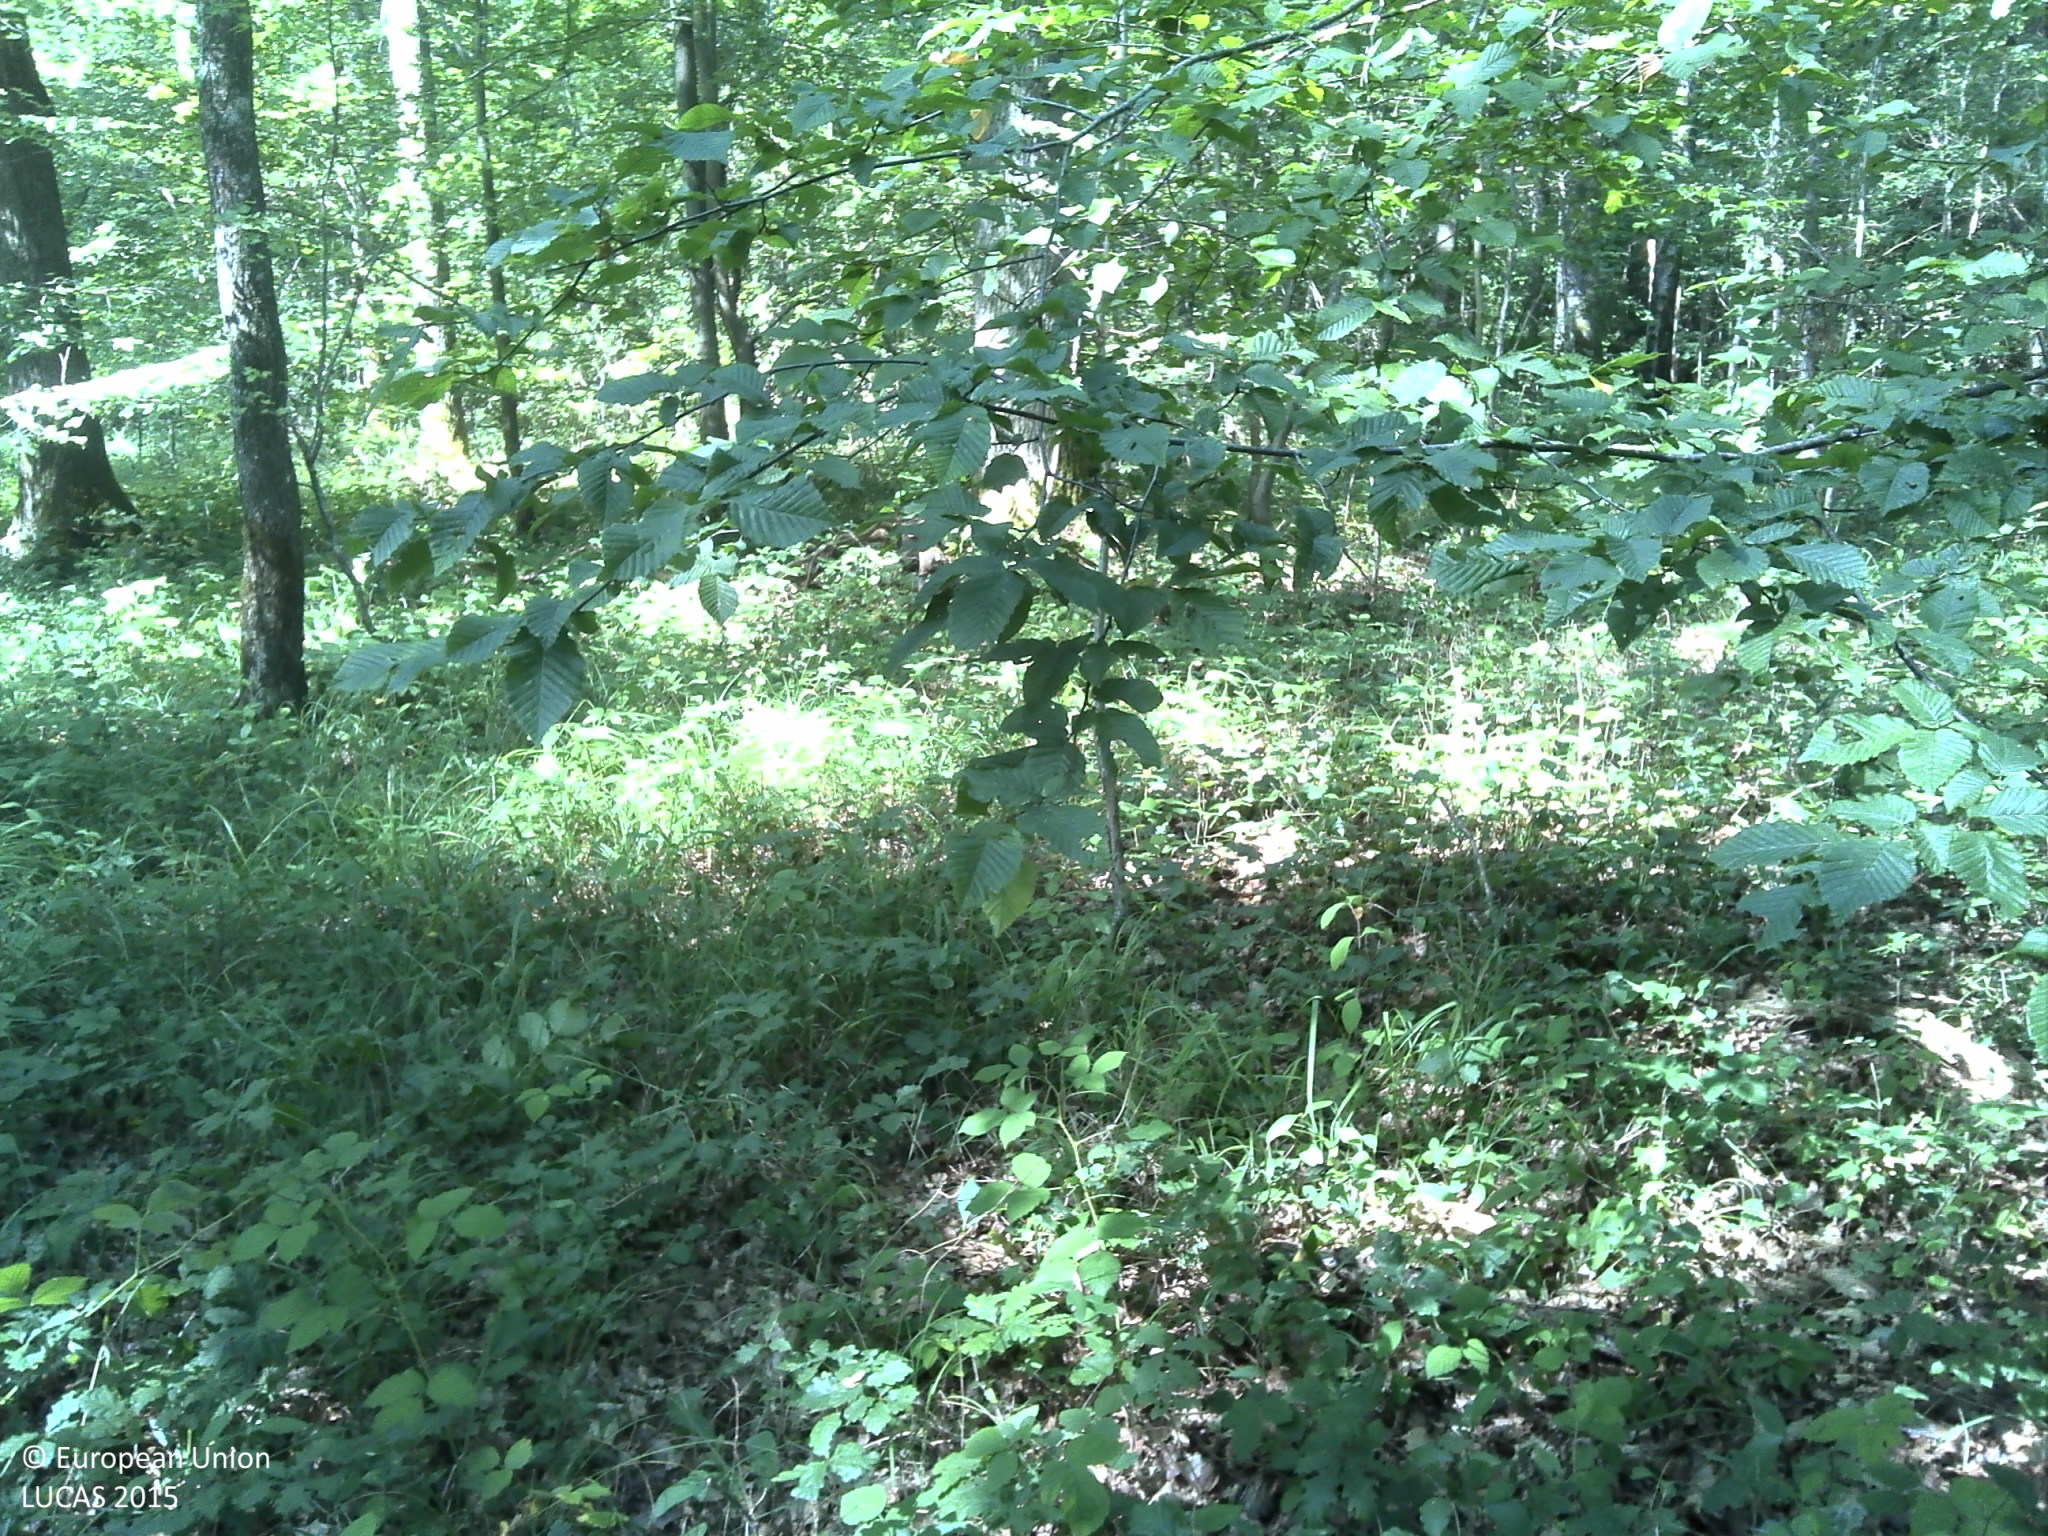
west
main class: Woodland
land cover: Broadleaved woodland
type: mesophytic deciduous forest
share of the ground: > 75 %
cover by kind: broadleaved forest trees 80 %, shrubs 10 %, herbaceous plants 10 %
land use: Forestry
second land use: Amenities, museums, leisure
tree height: > 5 m
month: August
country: FR
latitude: 48.6273
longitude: 1.8583
